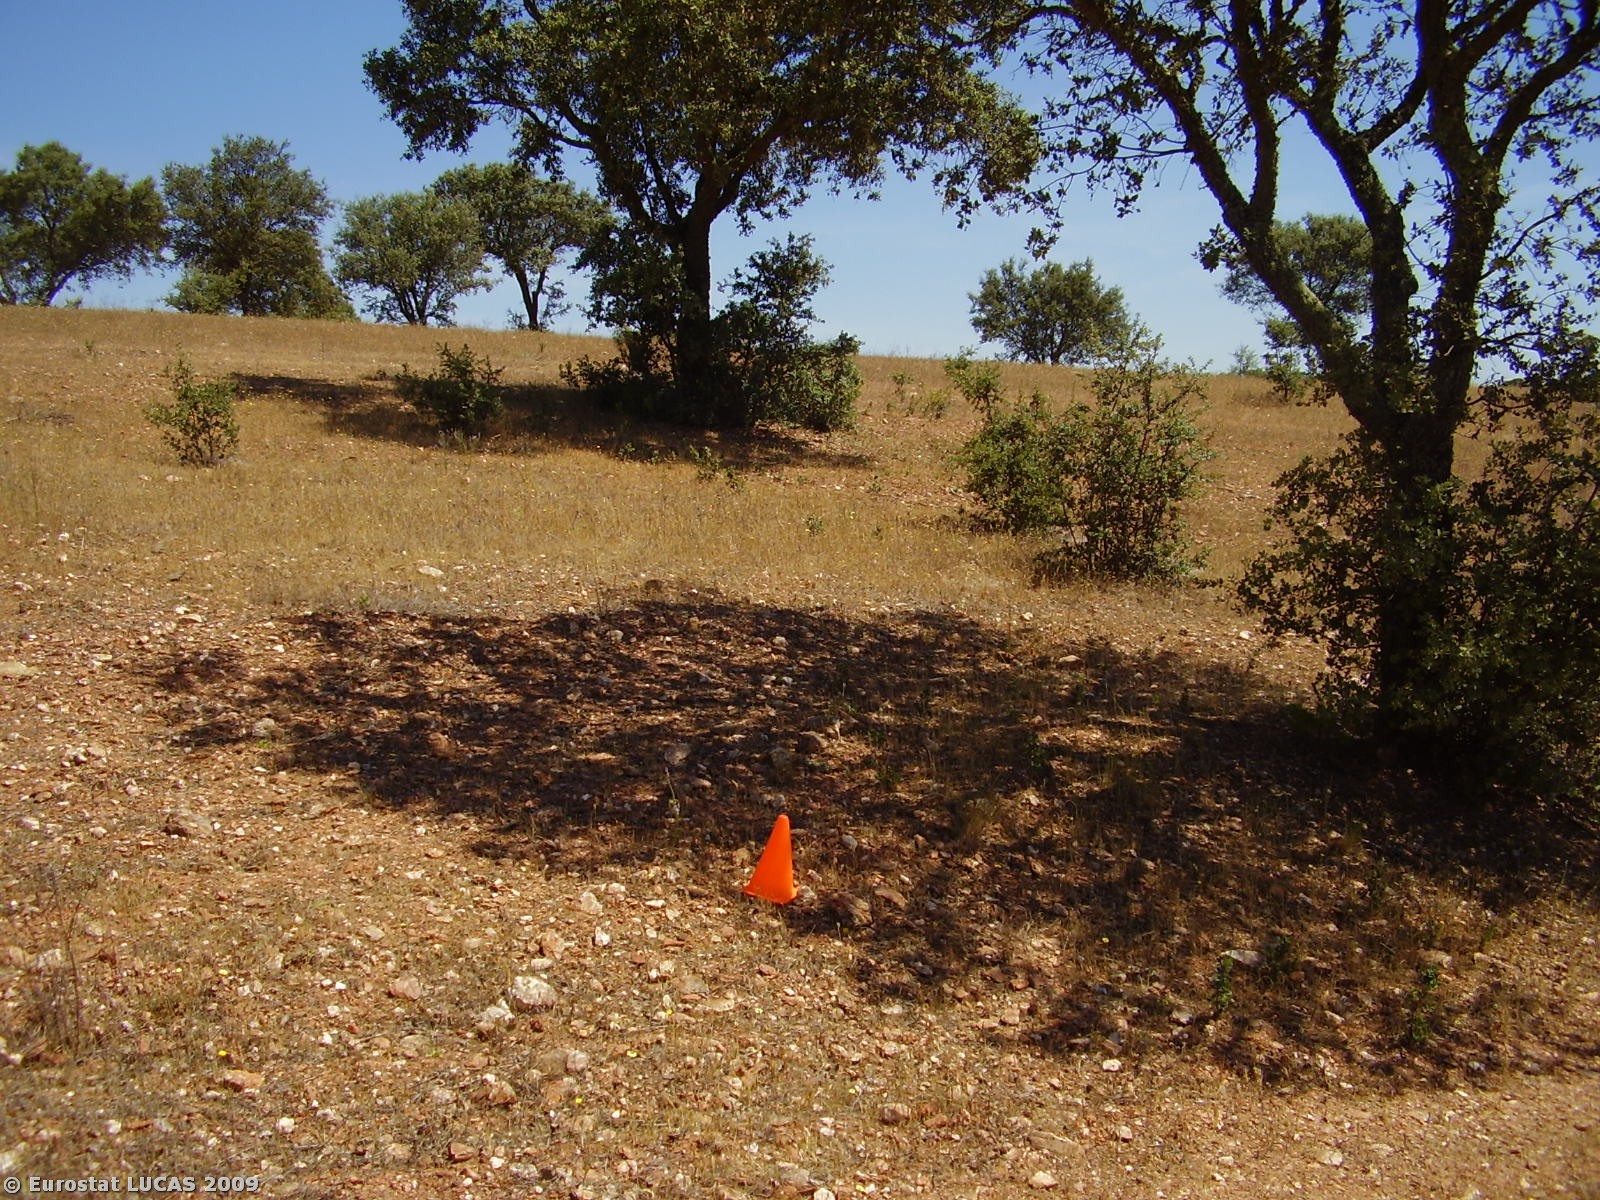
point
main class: Woodland
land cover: Broadleaved woodland
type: broadleaved evergreen forest
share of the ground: 10 - 25 %
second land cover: Bare land
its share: 25 - 50 %
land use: Forestry
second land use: Fallow land
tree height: > 5 m
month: May
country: PT
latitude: 37.7713
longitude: -7.7185
